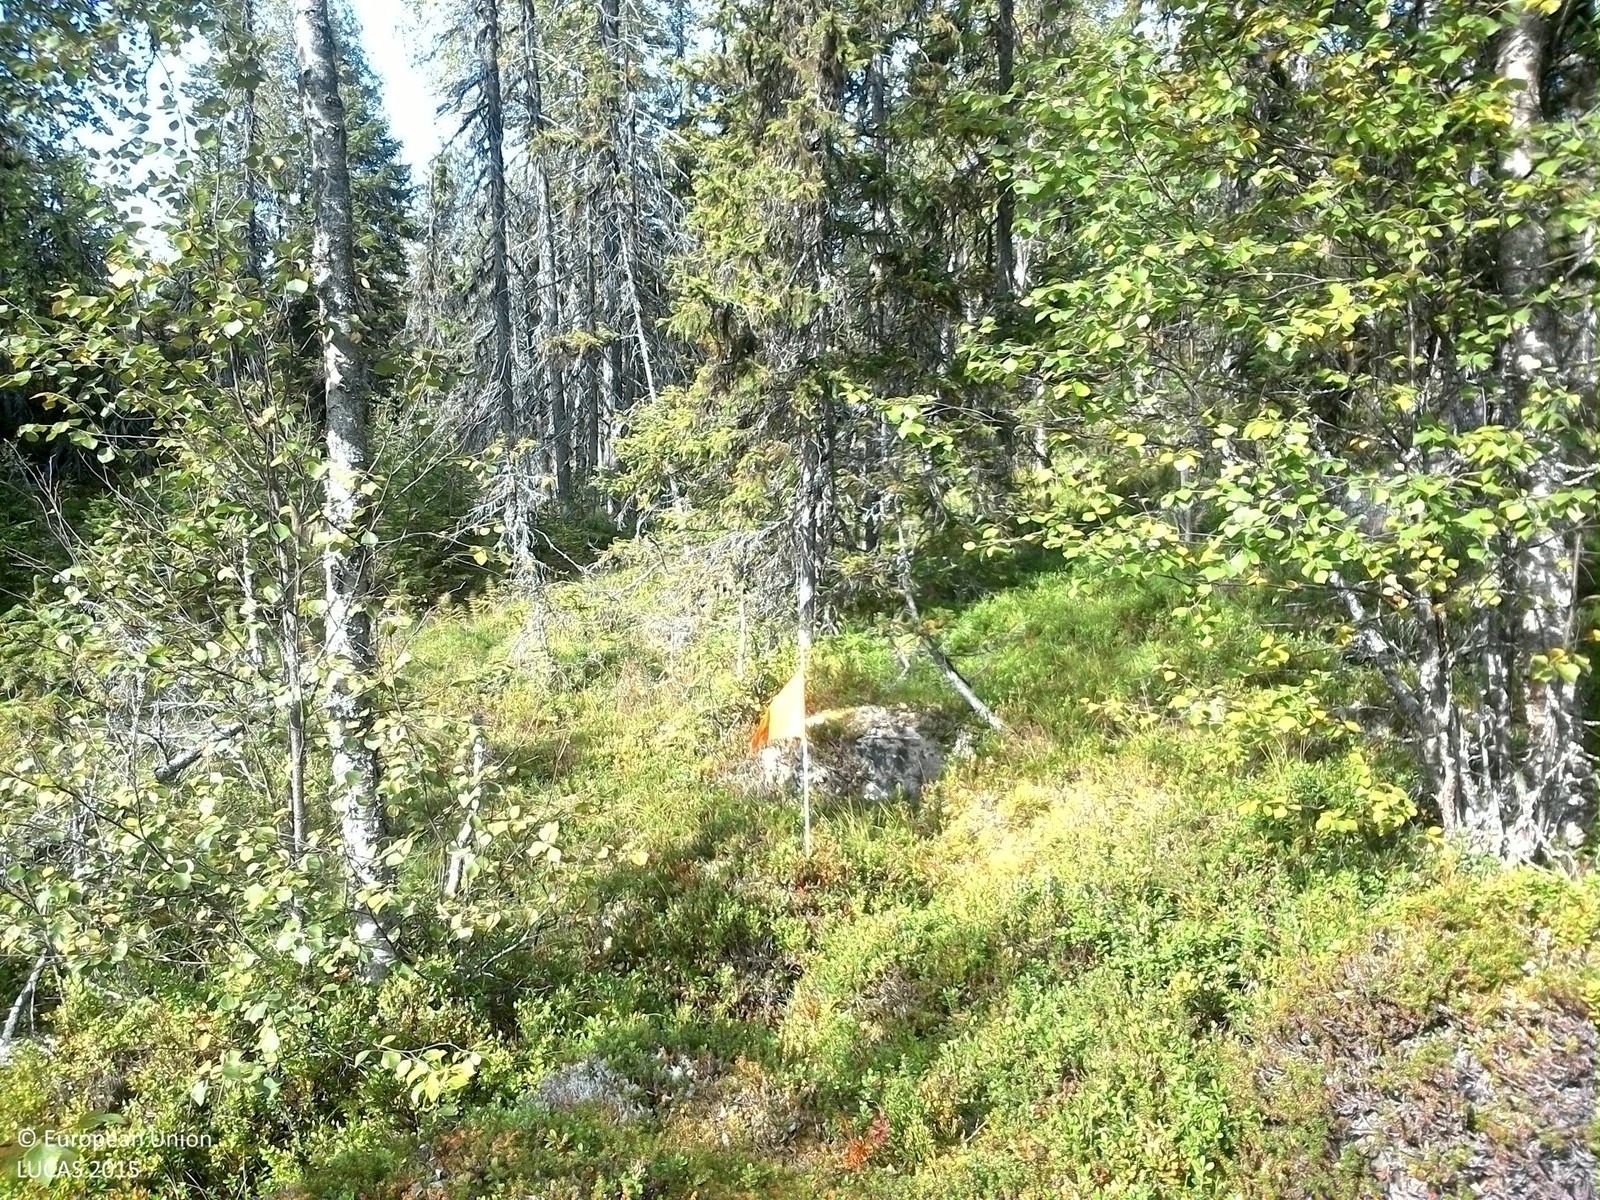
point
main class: Woodland
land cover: Spruce dominated mixed woodland
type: boreal forest
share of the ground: 25 - 50 %
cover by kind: coniferous forest trees 35 %, shrubs 30 %, lichens and mosses 20 %, broadleaved forest trees 15 %
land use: Forestry
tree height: > 5 m
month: September
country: SE
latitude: 61.7178
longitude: 14.3927
